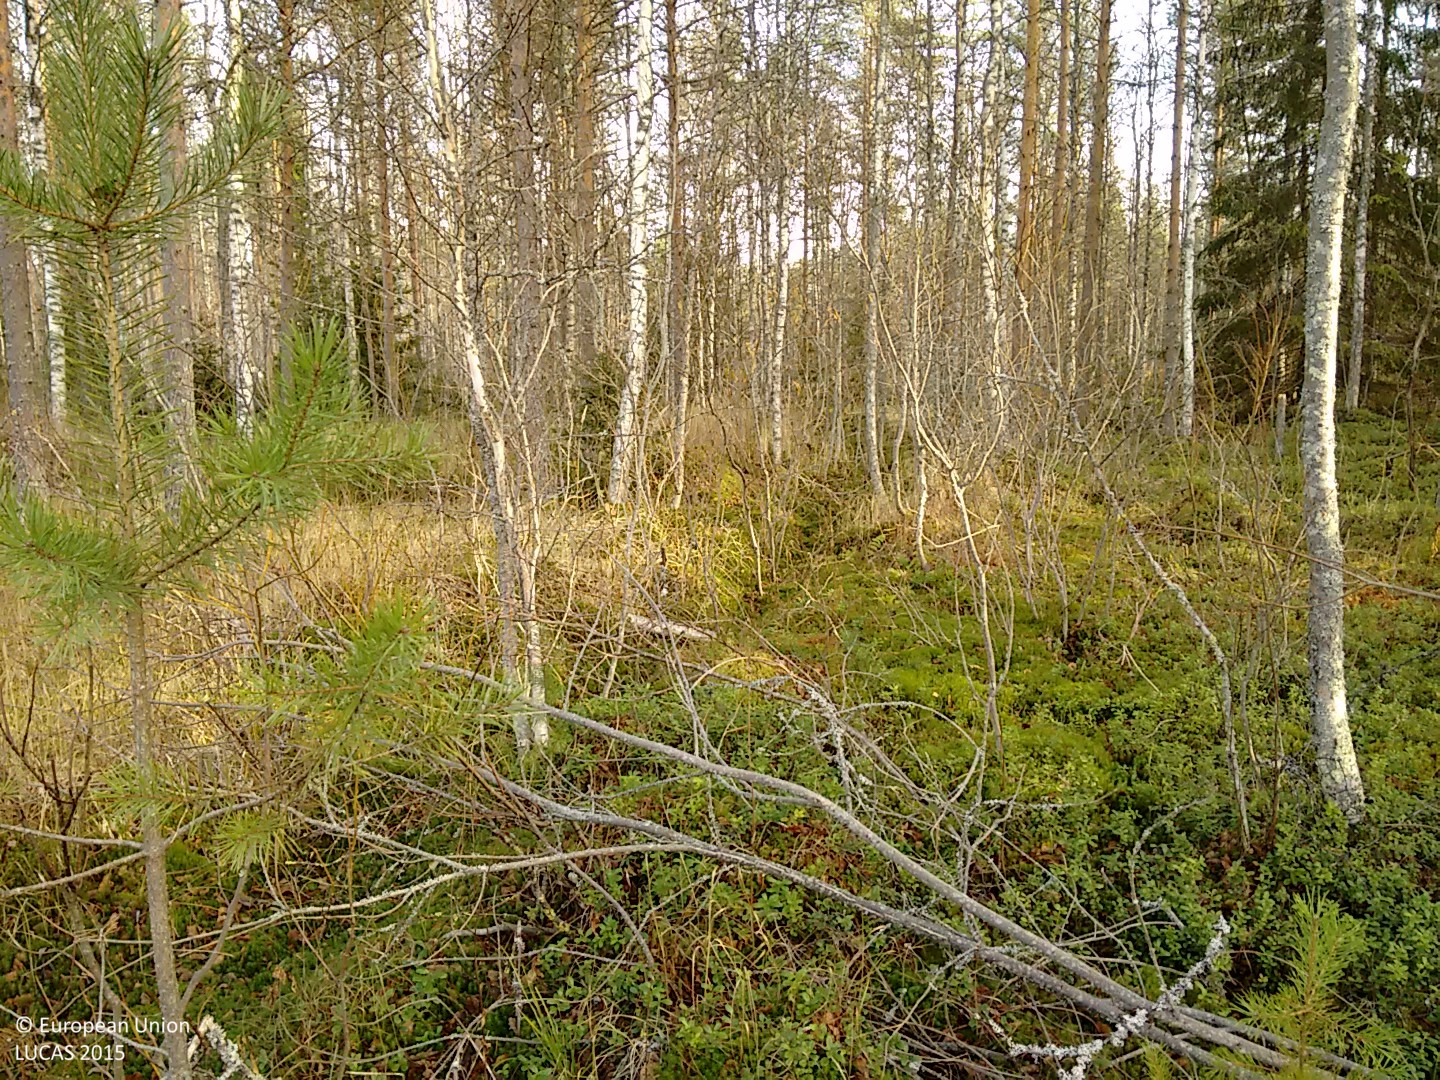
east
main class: Woodland
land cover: Pine dominated mixed woodland
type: boreal forest
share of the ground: > 75 %
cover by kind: broadleaved forest trees 45 %, coniferous forest trees 30 %, herbaceous plants 15 %, shrubs 10 %
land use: Forestry
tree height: > 5 m
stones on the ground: < 10 %
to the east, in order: Pine dominated mixed woodland; Managed hedges; Spontaneously vegetated surfaces; Electric lines; Spontaneously vegetated surfaces; Ditches and canals; Grass margins; Paved roads, cycling and walking lanes; Grass margins; Ditches and canals; Pine dominated mixed woodland; Ditches and canals; Shruby margins; Tracks; Grass margins; Pine dominated mixed woodland; Broadleaved woodland
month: October
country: FI
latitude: 63.9323
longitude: 25.2454
